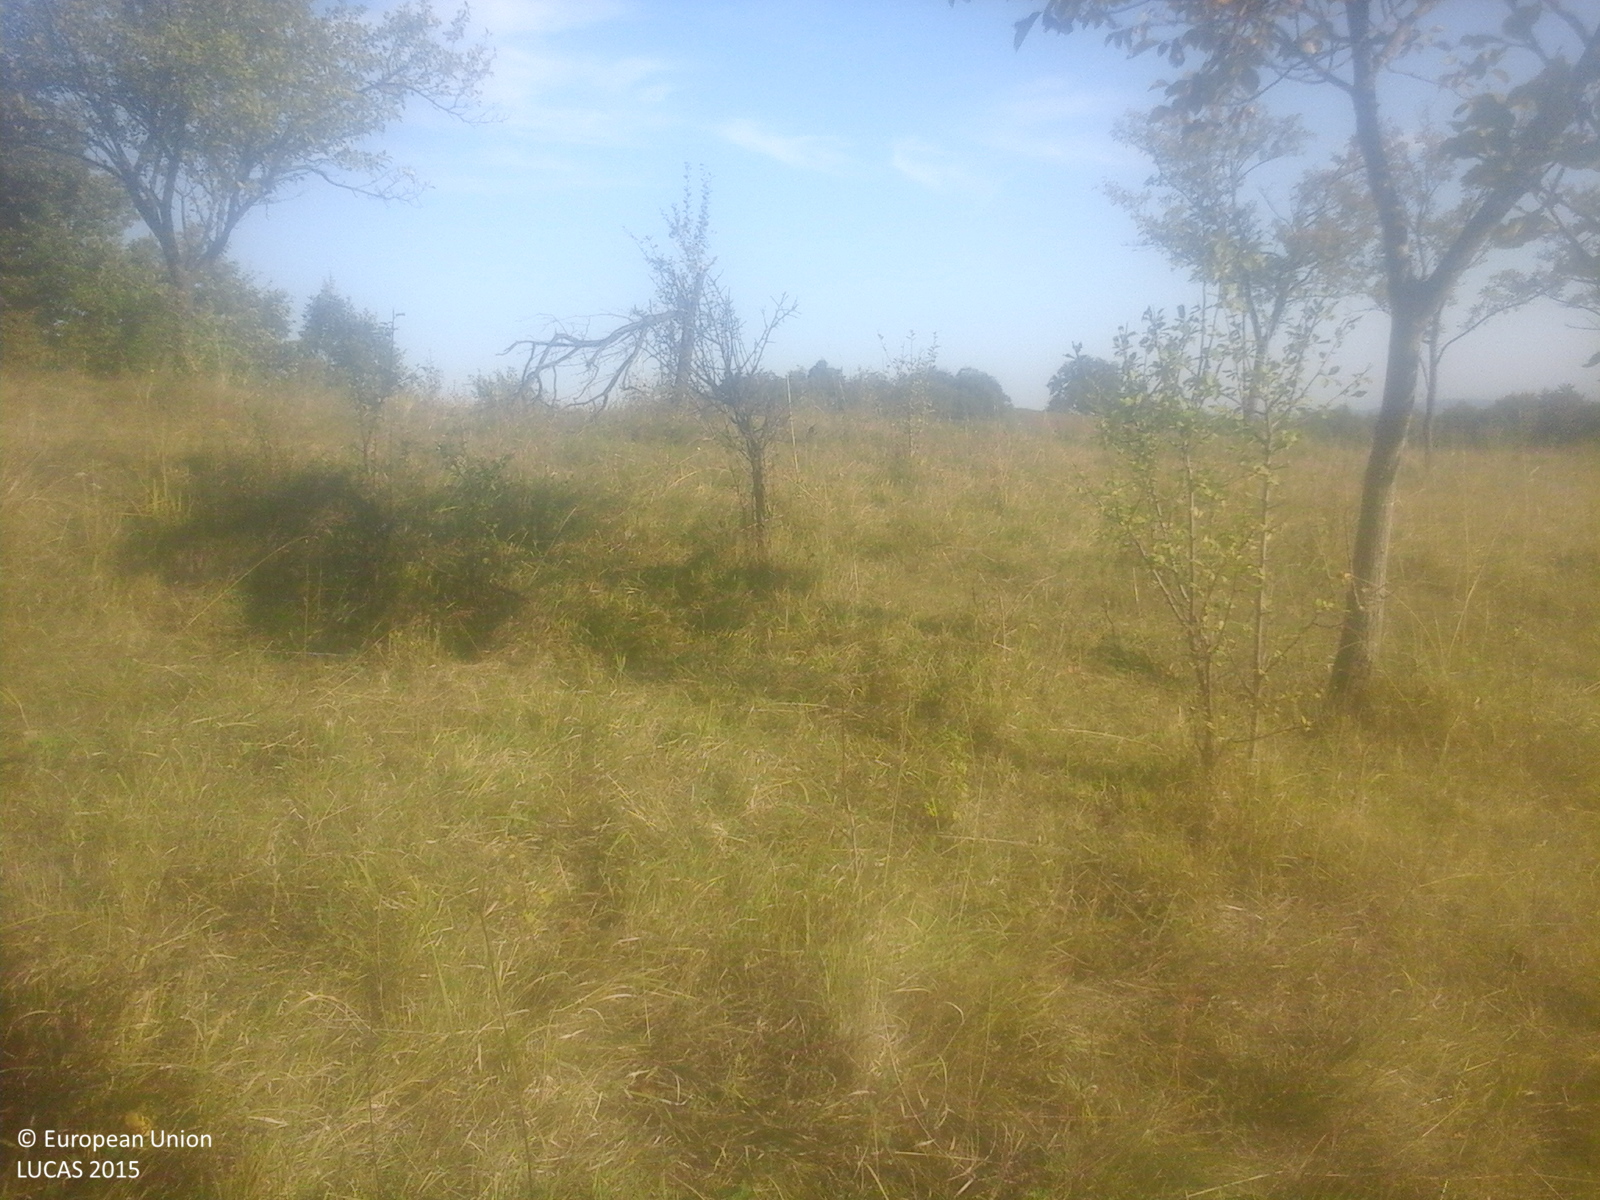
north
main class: Cropland
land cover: Apple fruit
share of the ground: > 75 %
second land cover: Grassland without tree/shrub cover
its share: > 75 %
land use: Agriculture (excluding fallow land and kitchen gardens)
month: September
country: RO
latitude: 46.6527
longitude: 22.1869
